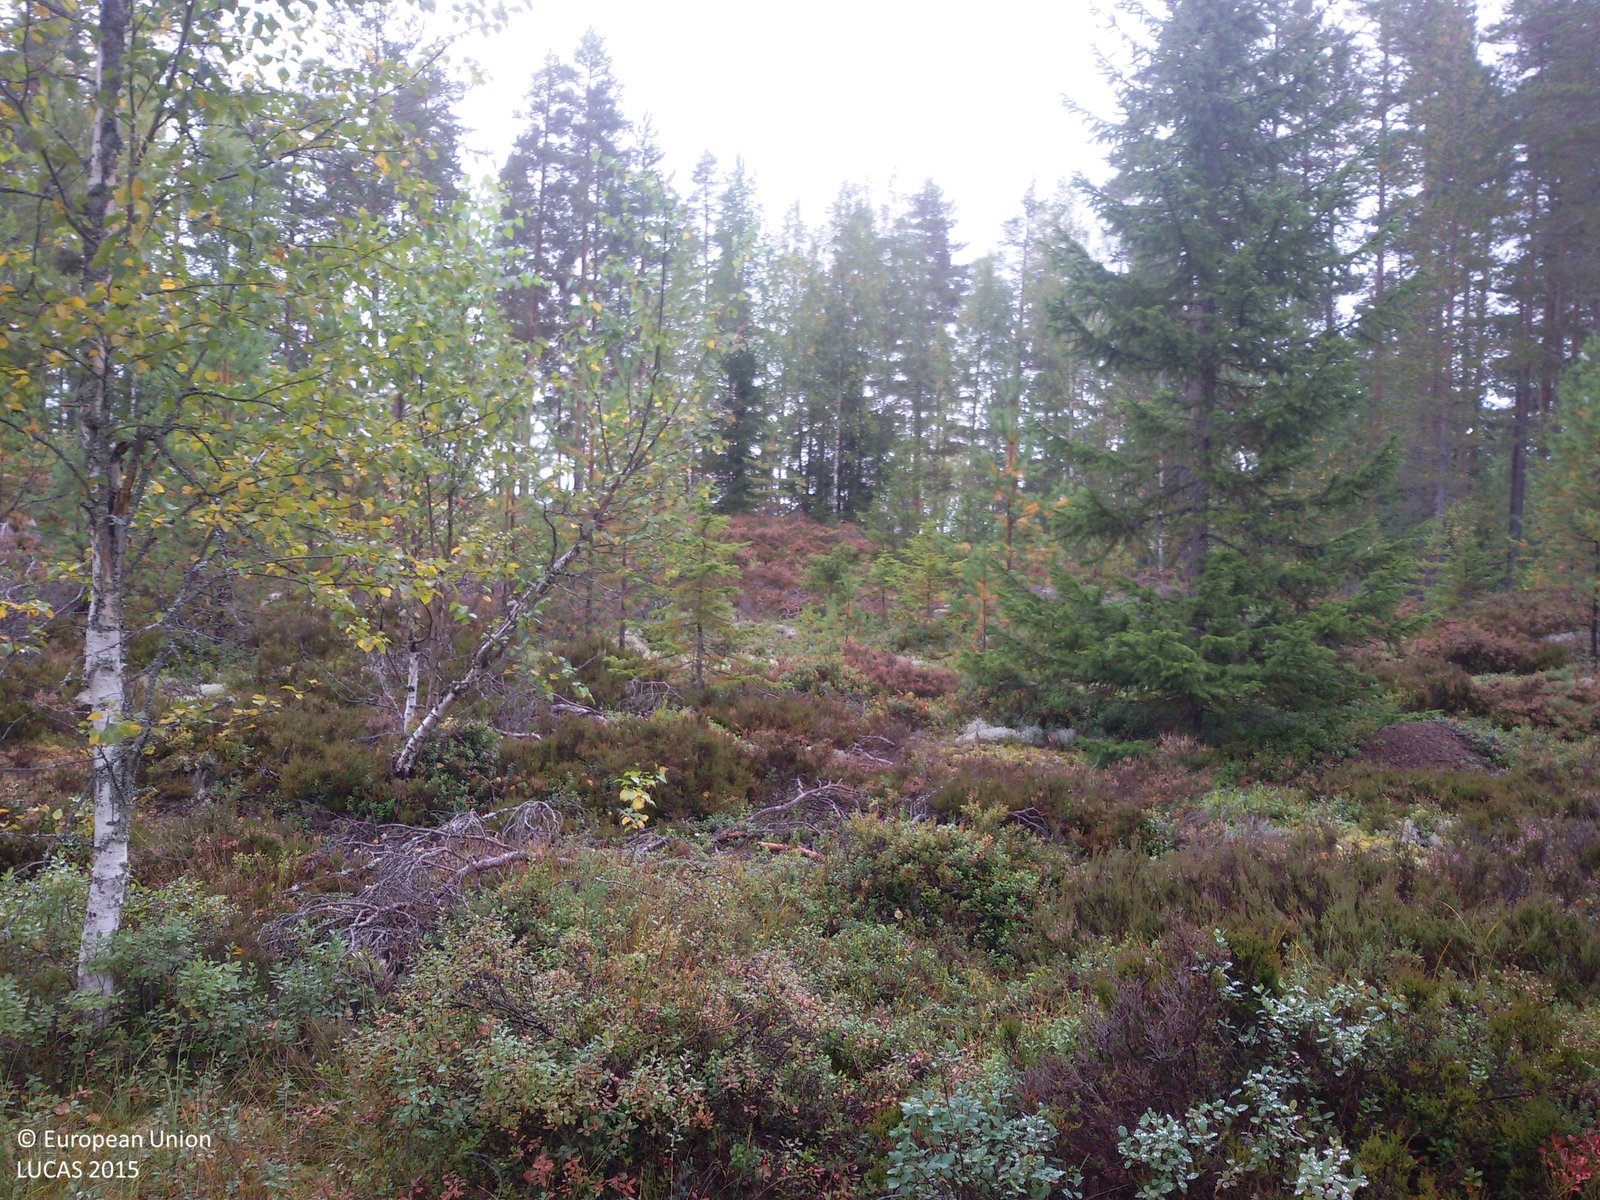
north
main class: Woodland
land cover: Pine dominated coniferous woodland
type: boreal forest
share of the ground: 50 - 75 %
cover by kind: coniferous forest trees 50 %, shrubs 25 %, lichens and mosses 25 %
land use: Forestry
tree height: > 5 m
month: September
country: SE
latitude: 61.0349
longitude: 14.3000
